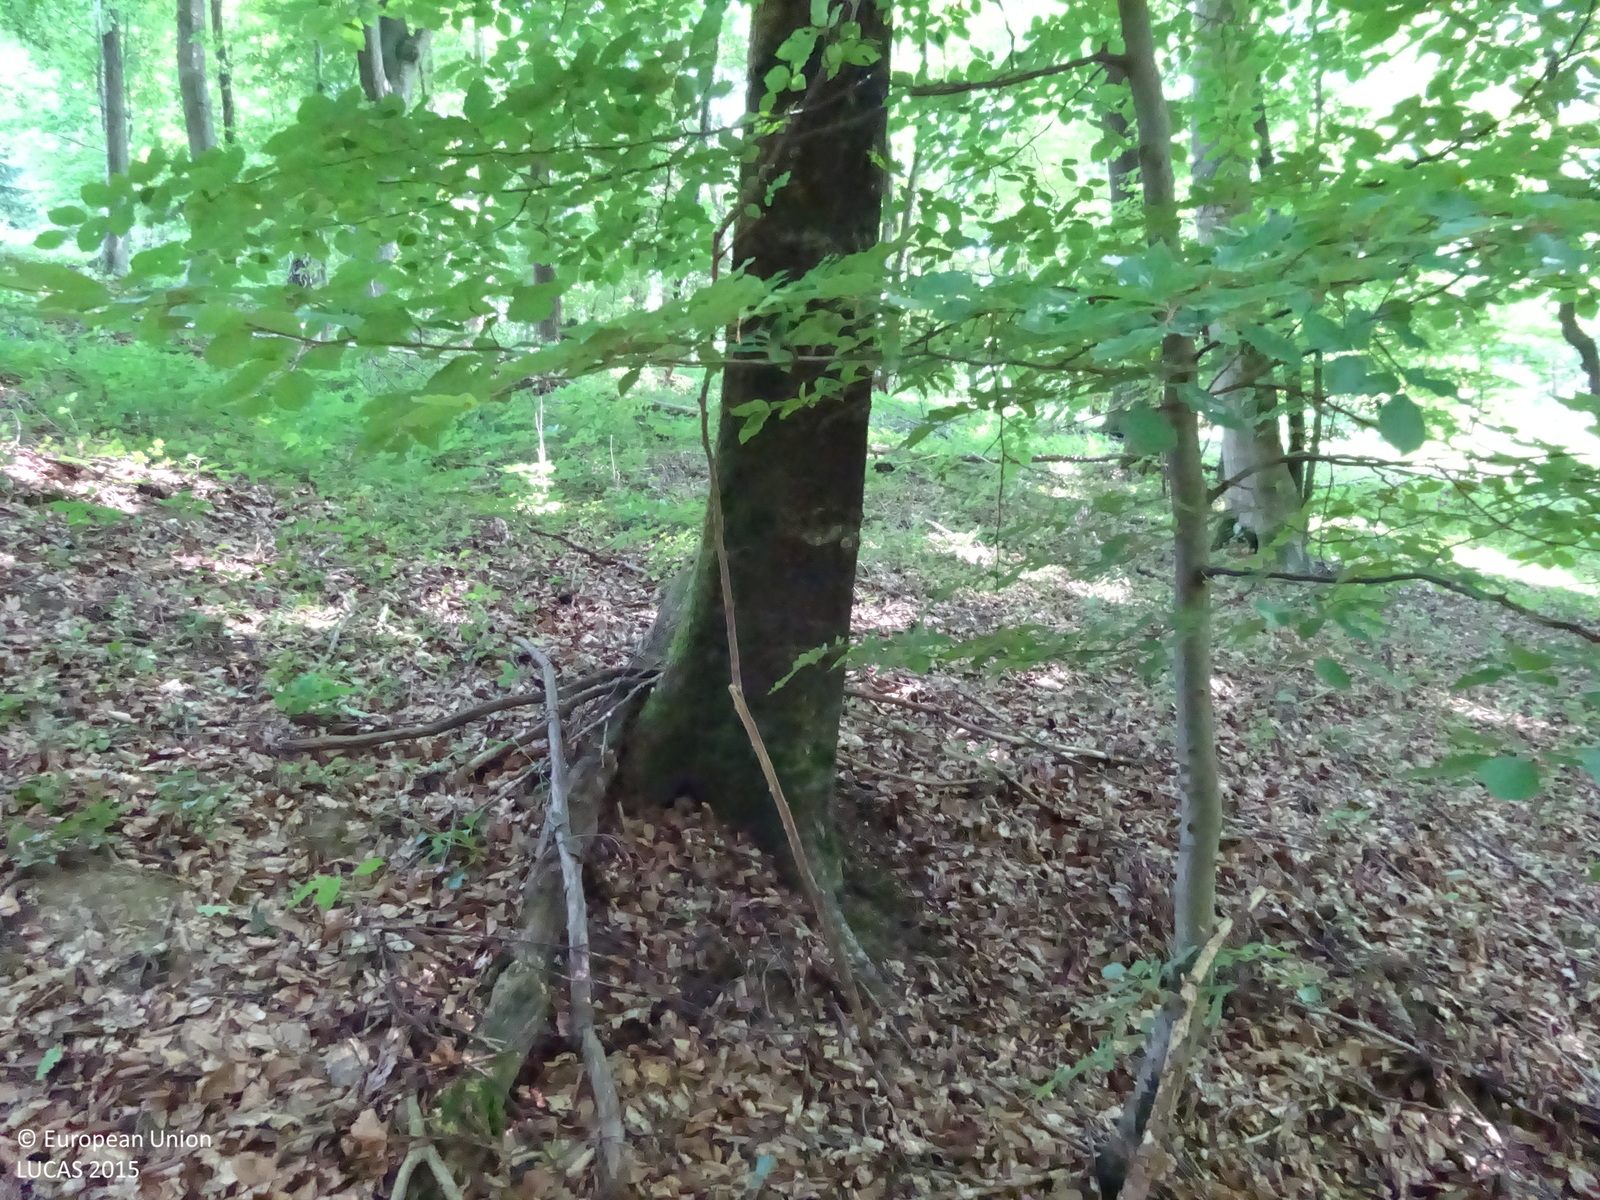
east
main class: Woodland
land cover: Broadleaved woodland
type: mountainous beech forest
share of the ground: > 75 %
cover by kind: broadleaved forest trees 95 %, coniferous forest trees 5 %
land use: Forestry
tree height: > 5 m
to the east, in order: Broadleaved woodland; Grassland without tree/shrub cover; Tracks; Broadleaved woodland; Electric lines; Broadleaved woodland; Grassland without tree/shrub cover; Paved roads, cycling and walking lanes; Grassland without tree/shrub cover; Shrubland without tree cover; Tracks; Apple fruit; Grassland without tree/shrub cover; Grassland with sparse tree/shrub cover; Artificial constructions in urban areas
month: July
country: AT
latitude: 46.9006
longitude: 16.0787
